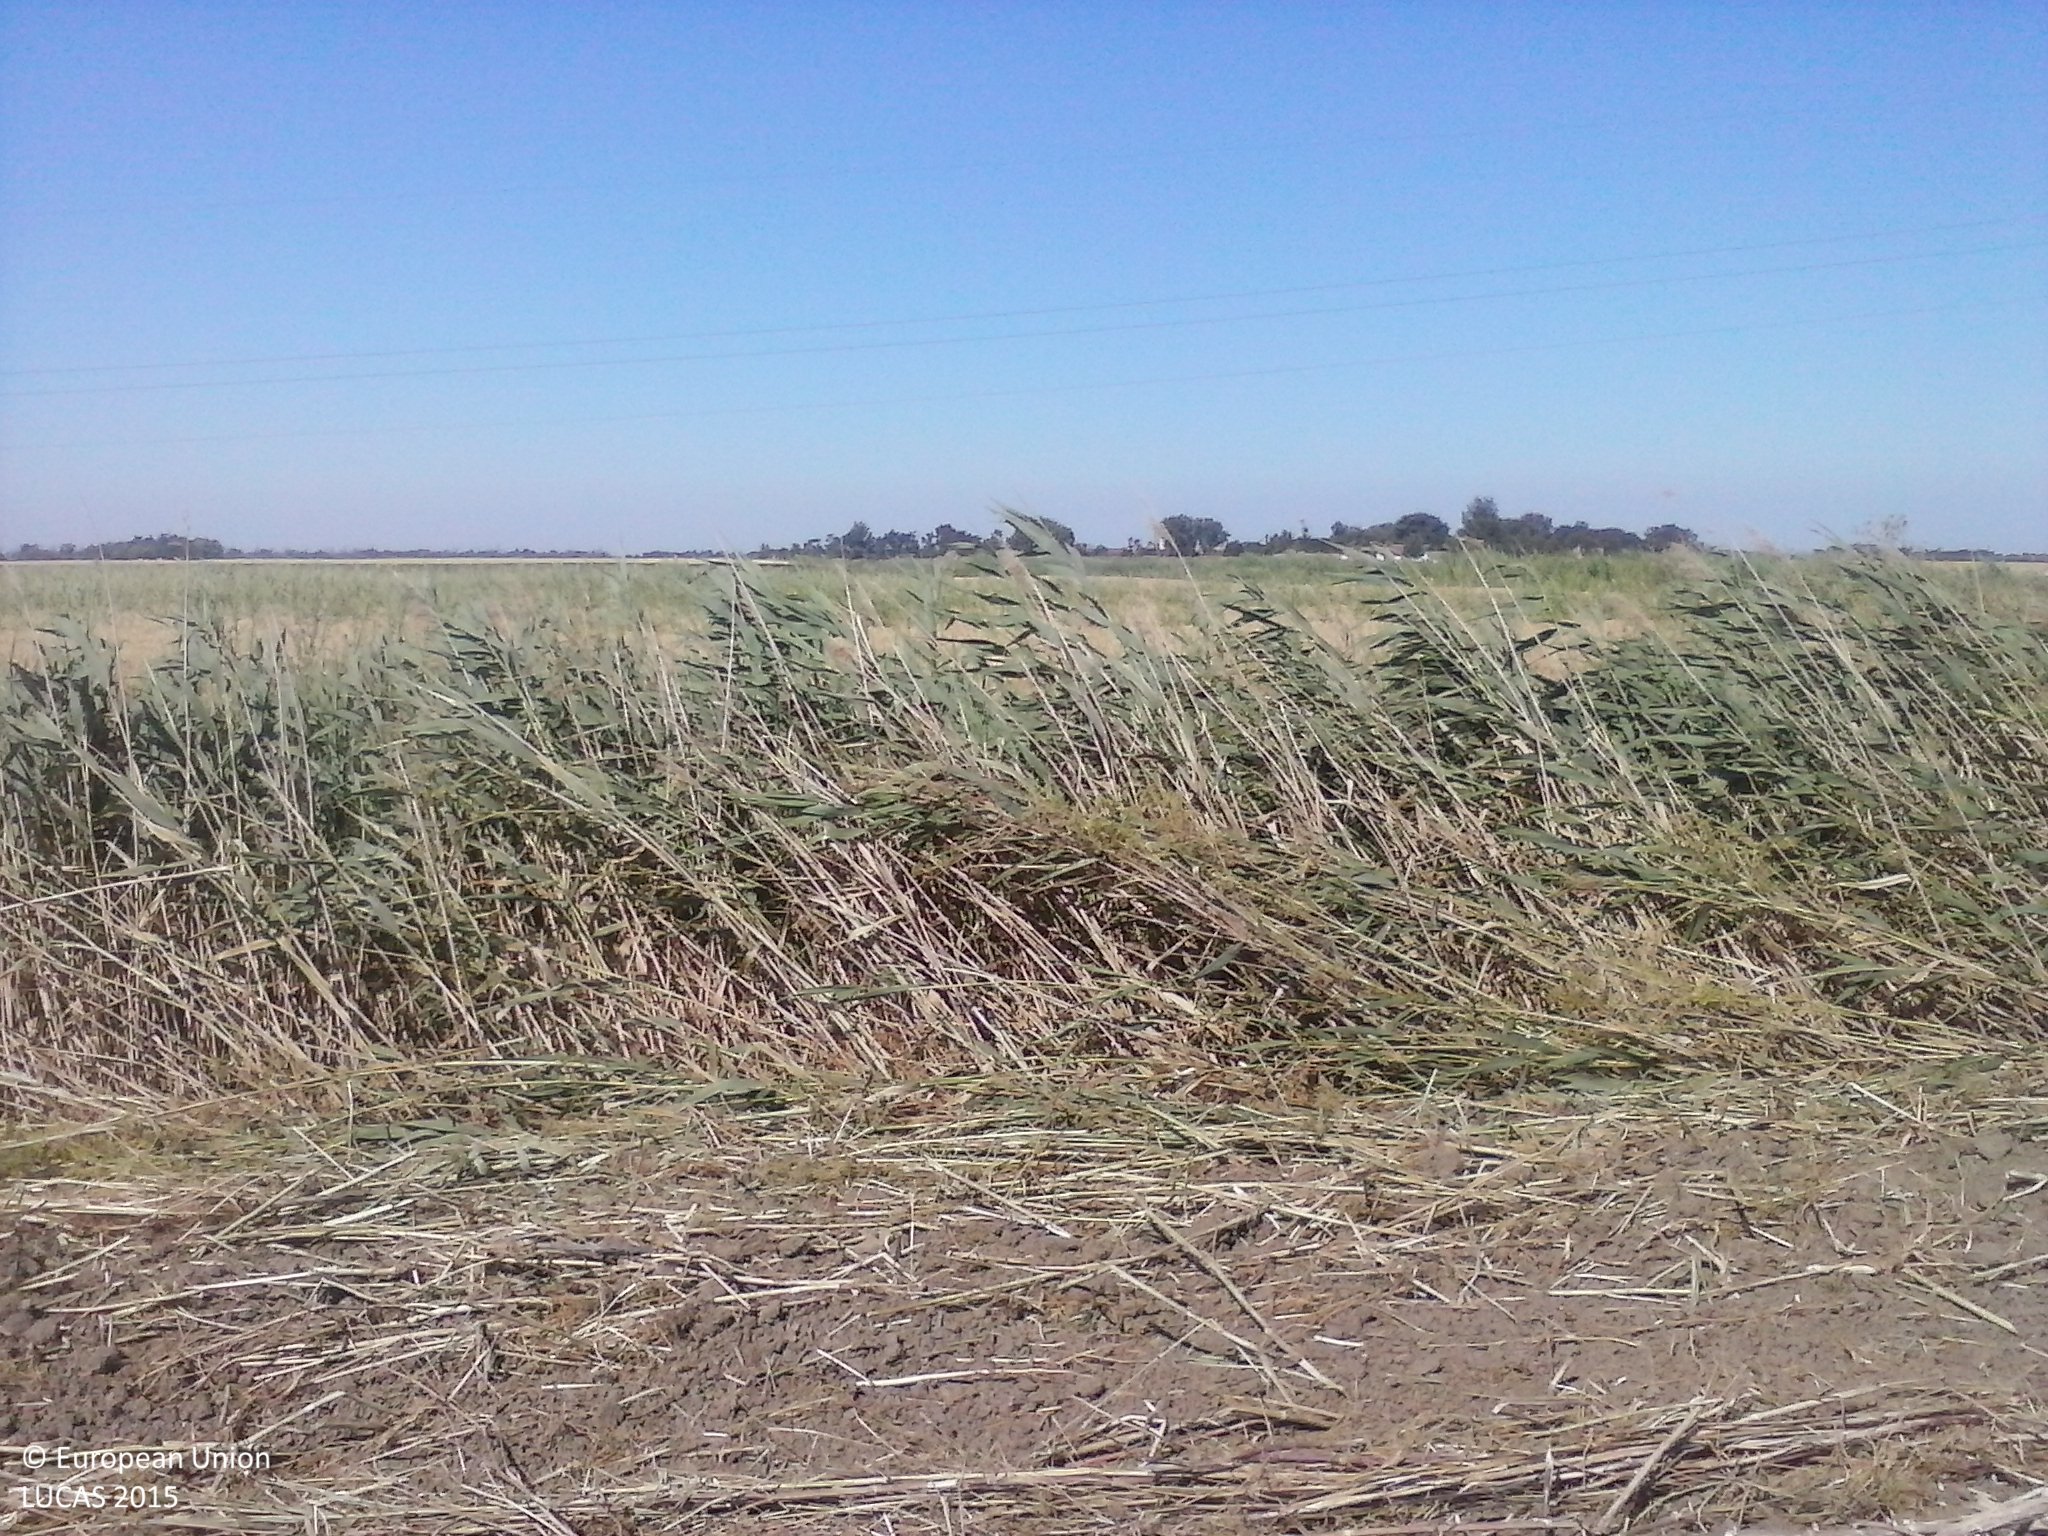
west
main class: Cropland
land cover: Rape and turnip rape
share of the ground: < 10 %
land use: Agriculture (excluding fallow land and kitchen gardens)
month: March
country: HU
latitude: 46.4623
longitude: 20.3770
